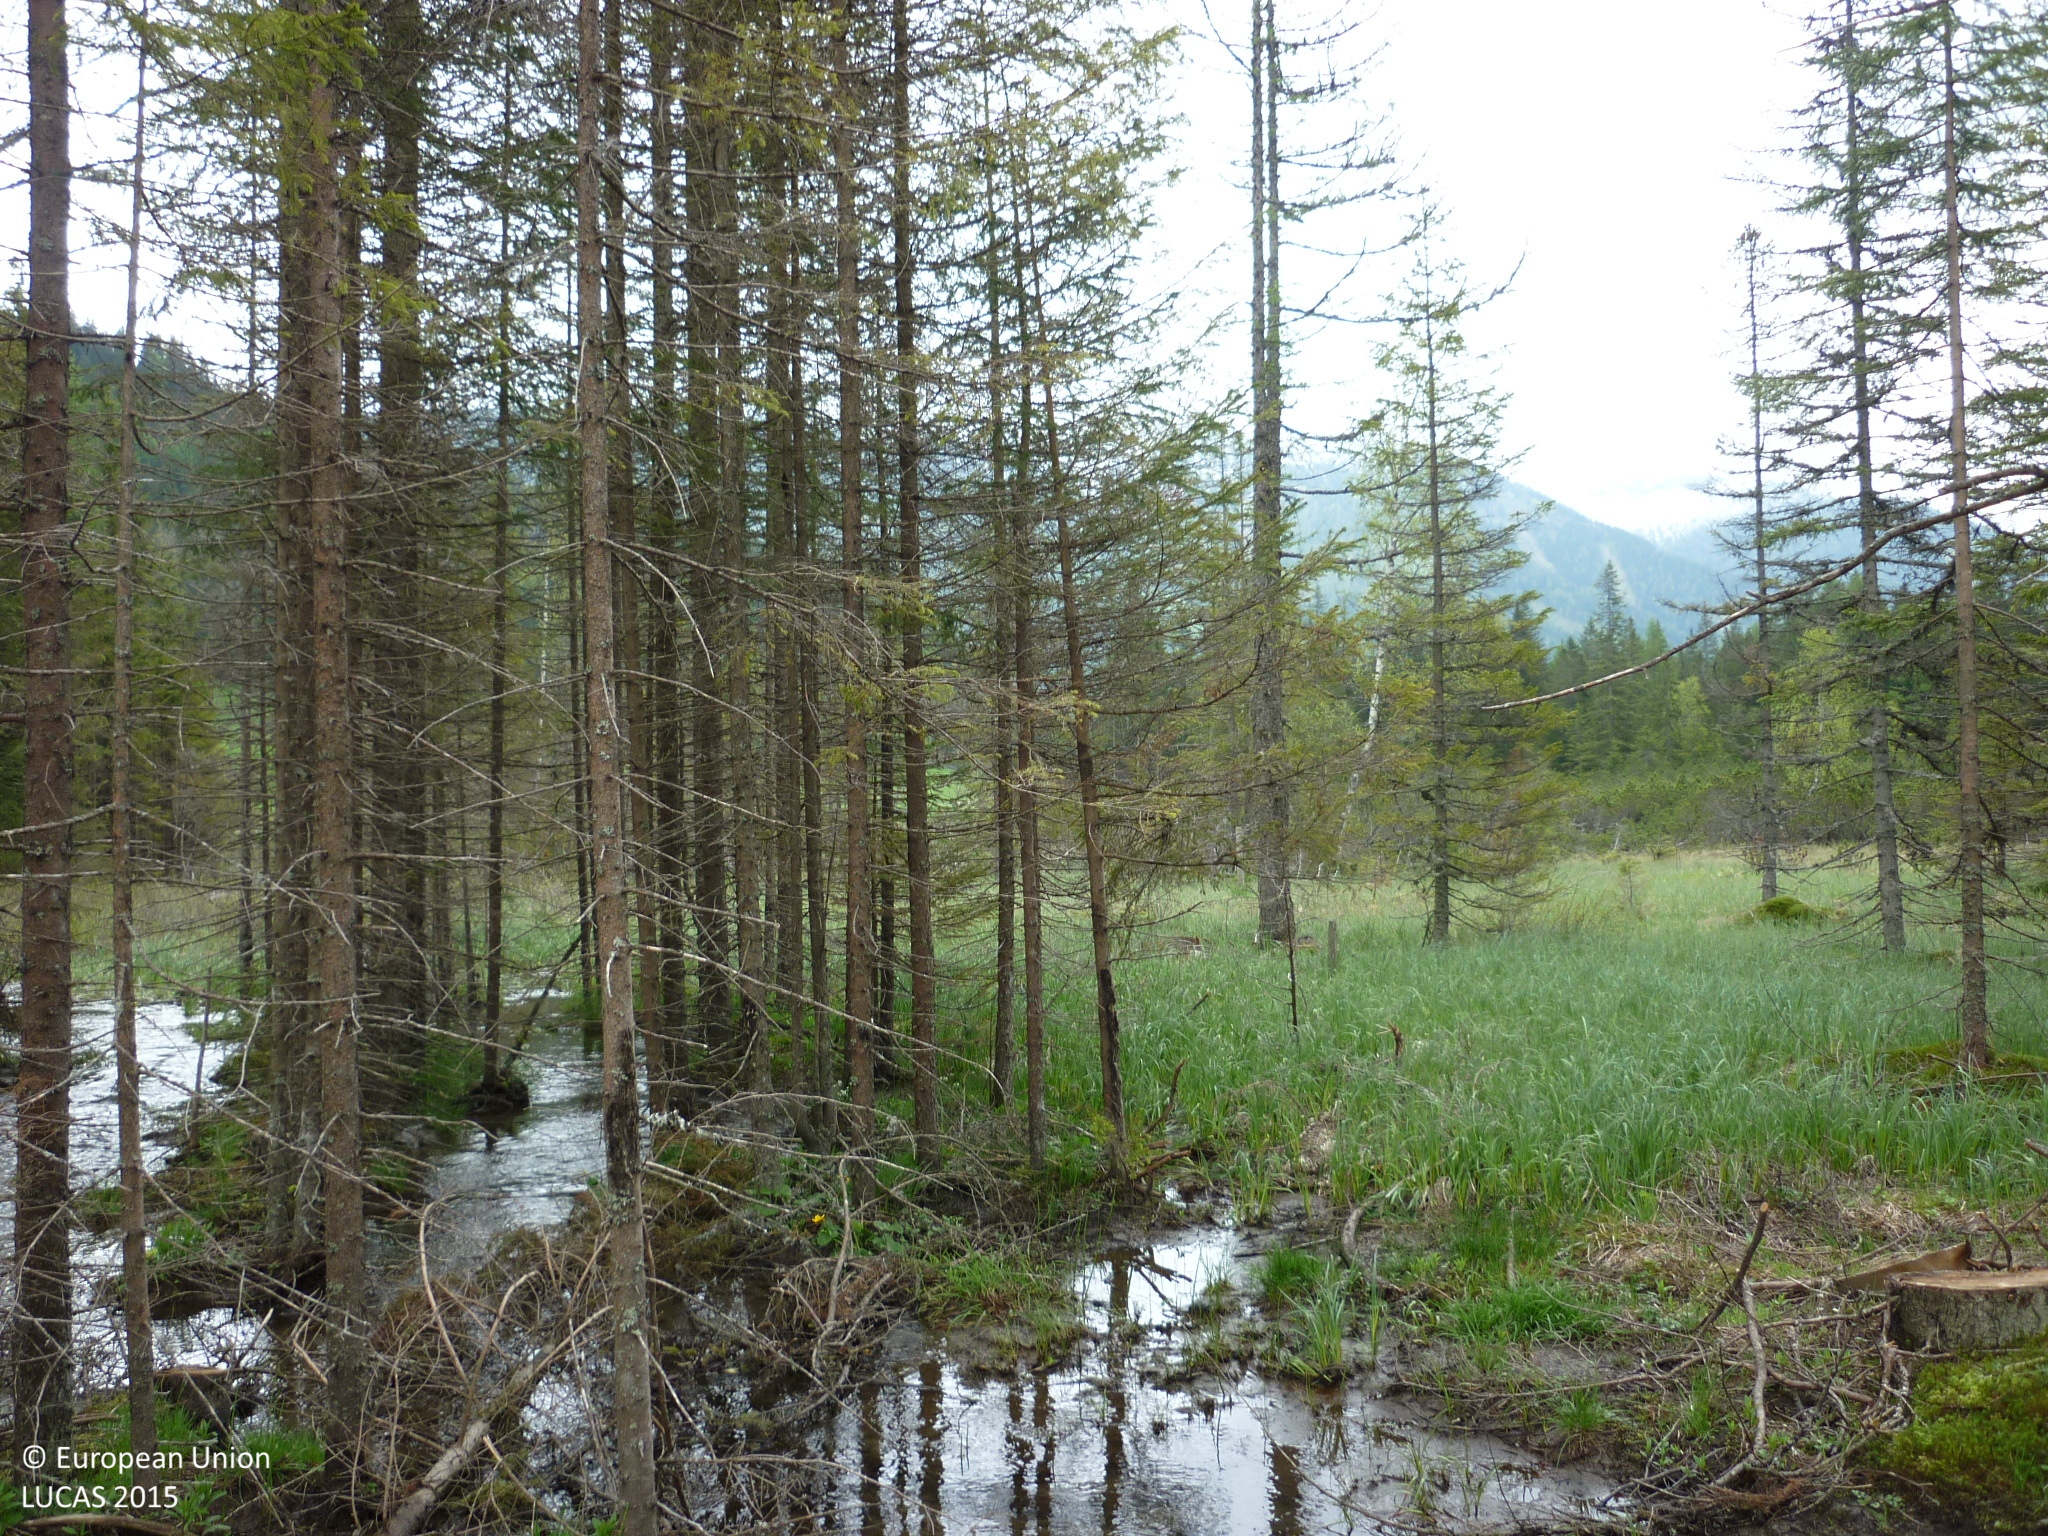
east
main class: Woodland
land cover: Spruce dominated coniferous woodland
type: alpine coniferous forest
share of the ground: 50 - 75 %
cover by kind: coniferous forest trees 60 %, consolidated bare surface 10 %, unconsolidated bare surface 10 %
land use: Forestry
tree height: > 5 m
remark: Temporary flooded
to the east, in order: Spruce dominated coniferous woodland; Spontaneously vegetated surfaces; Spruce dominated coniferous woodland; Rivers and streams; Rocks and stones; Rivers and streams; Grassland with sparse tree/shrub cover; Rivers and streams; Spruce dominated mixed woodland; Inland fresh running water; Grassland without tree/shrub cover; Rivers and streams; Grassland without tree/shrub cover
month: May
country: AT
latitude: 47.4132
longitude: 14.4389
